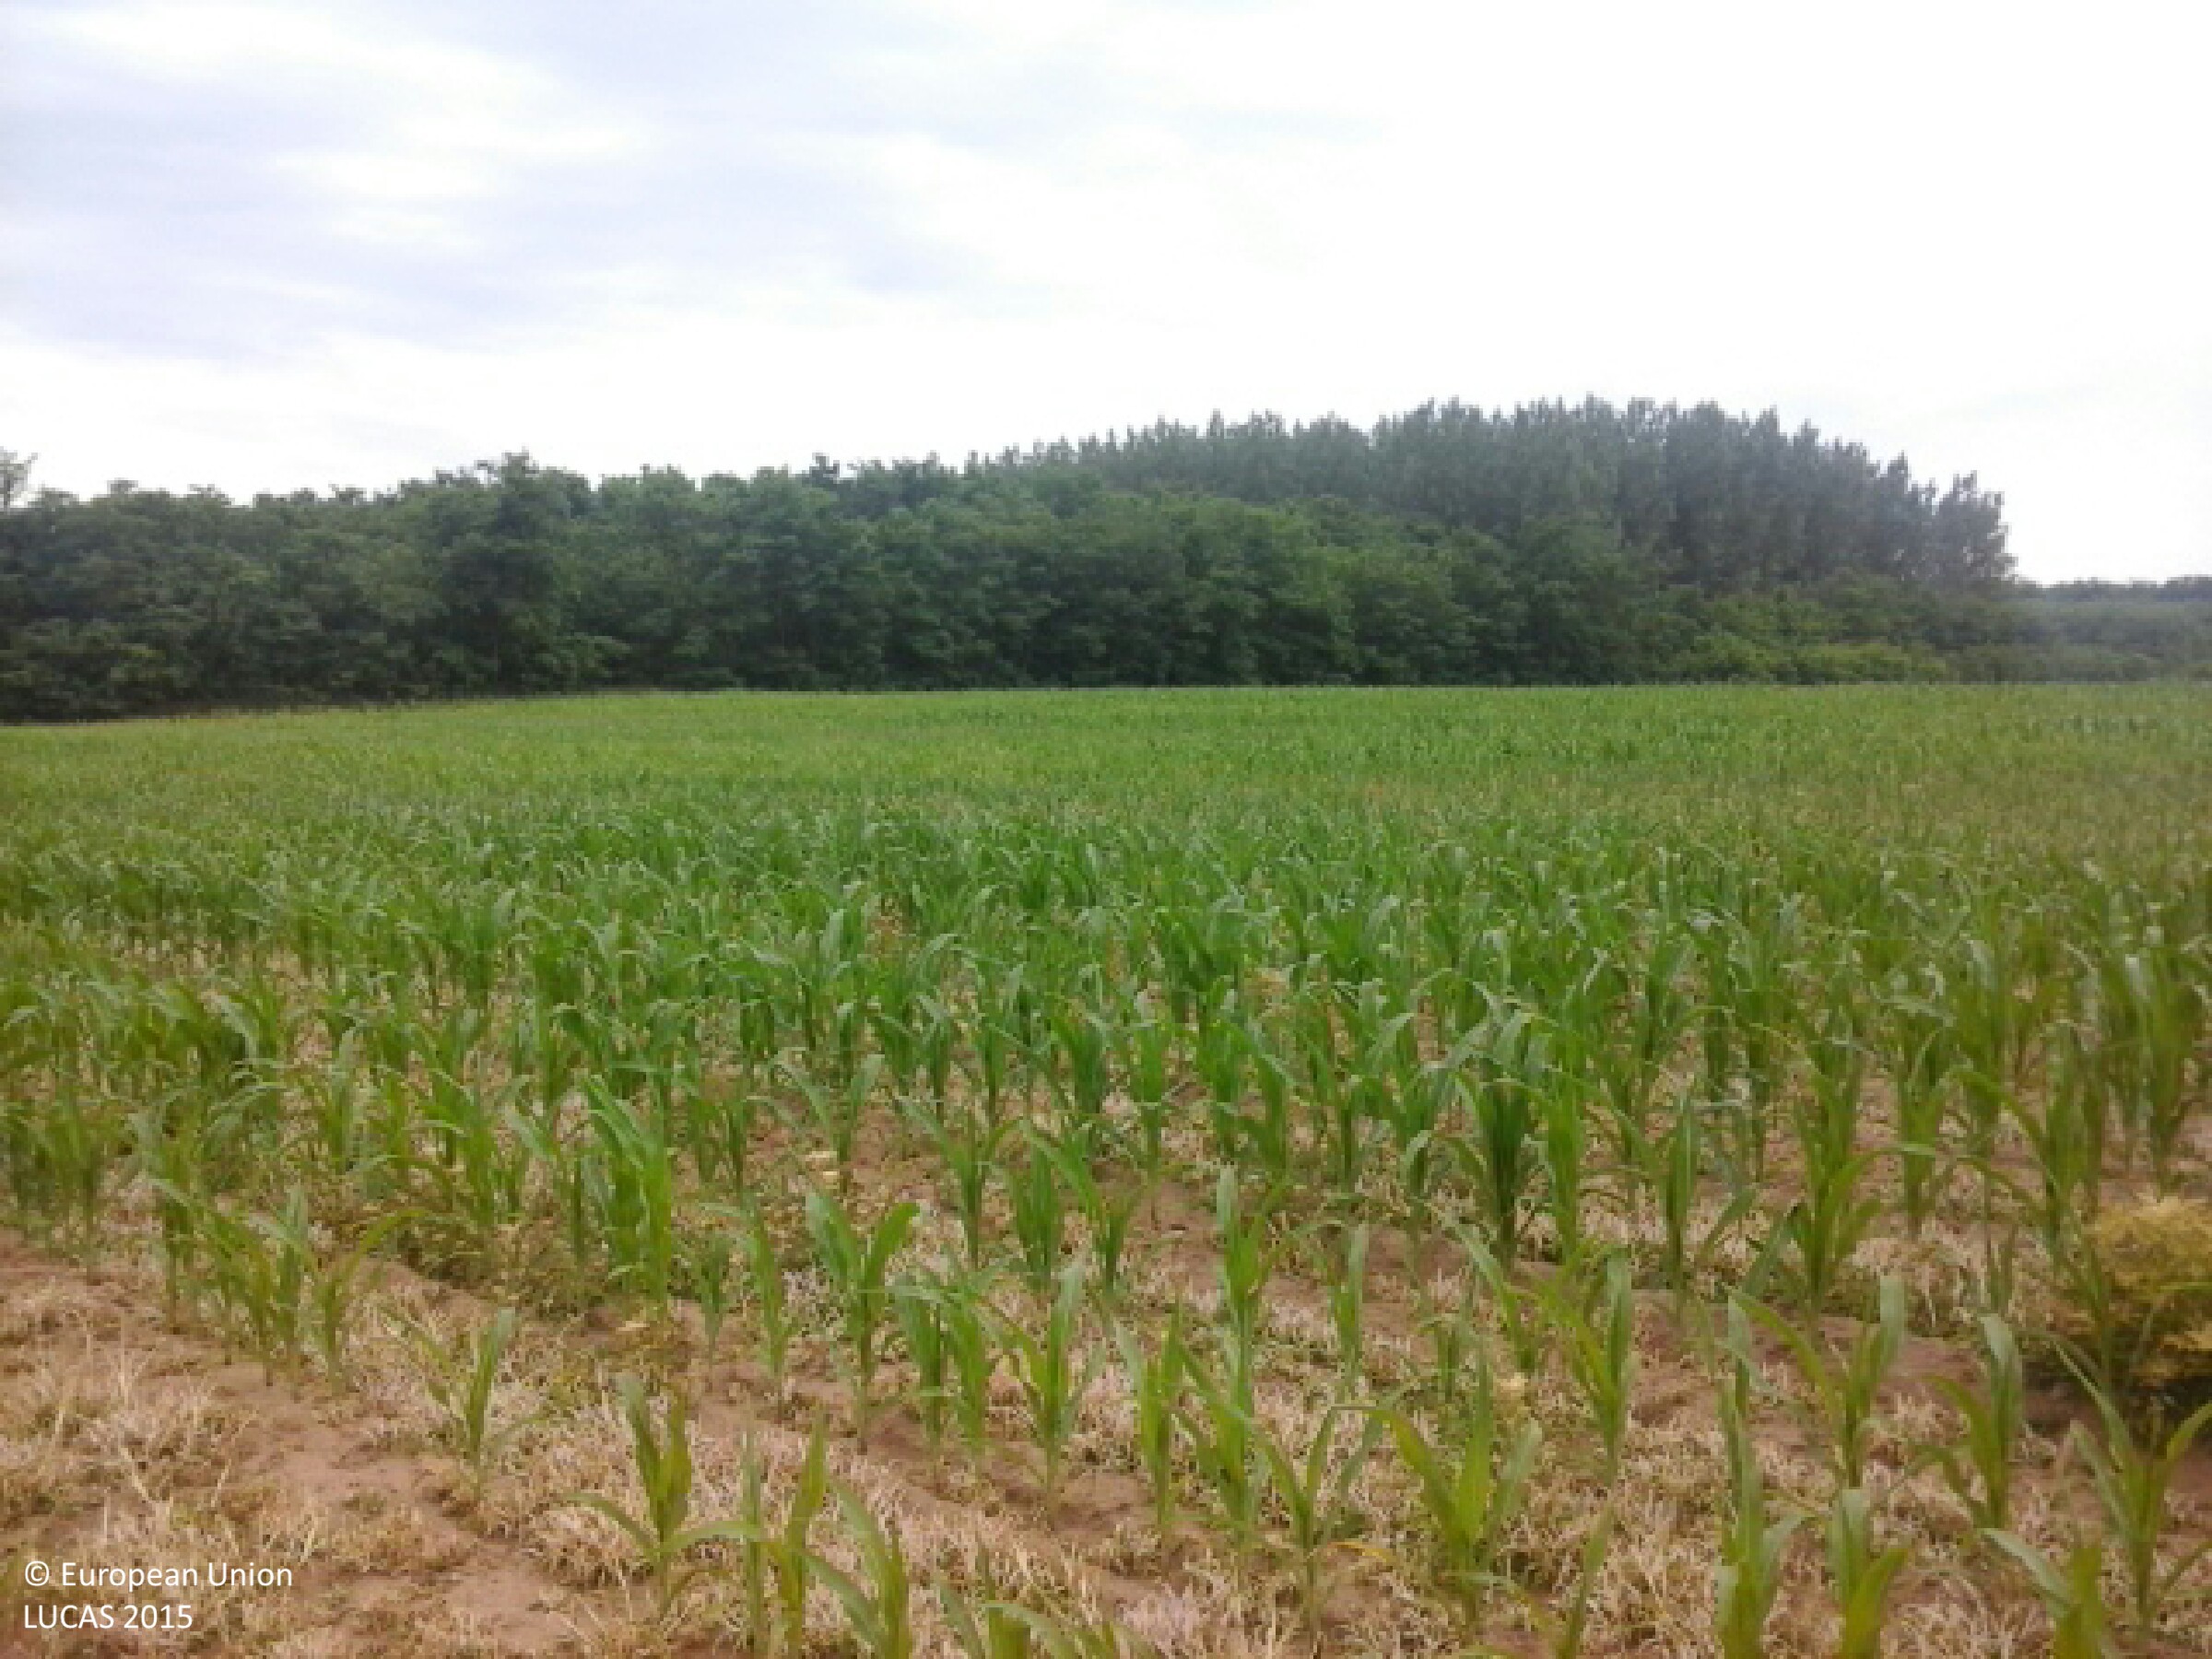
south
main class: Cropland
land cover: Maize
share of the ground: 25 - 50 %
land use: Agriculture (excluding fallow land and kitchen gardens)
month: June
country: HU
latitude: 47.9879
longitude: 22.1267
